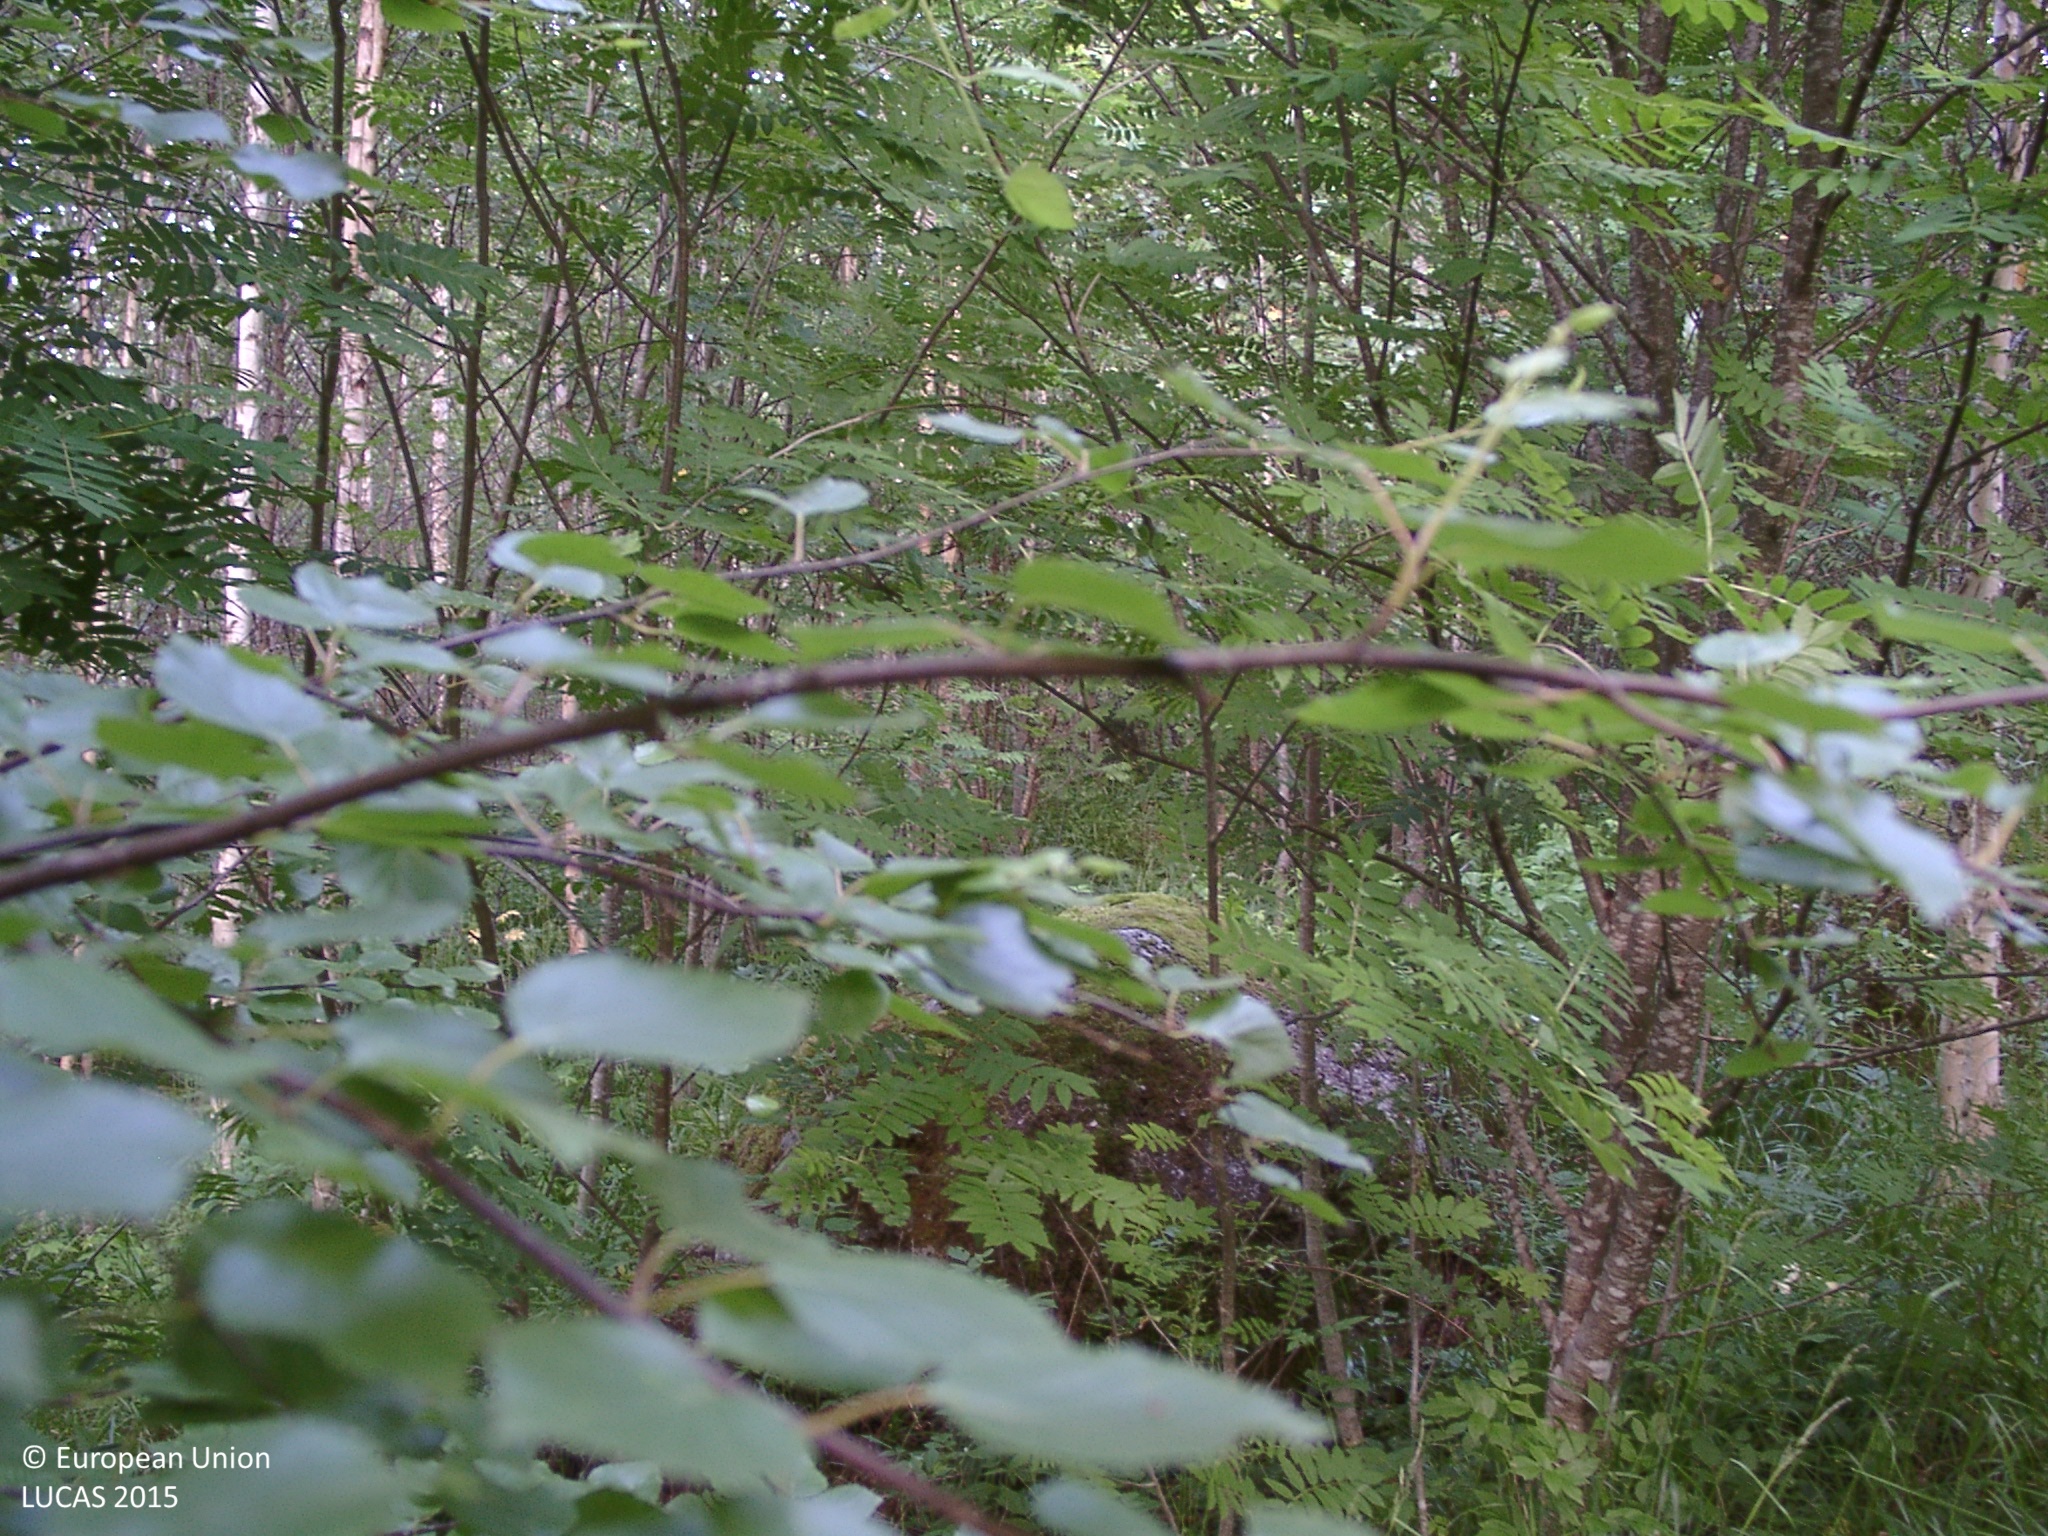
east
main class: Woodland
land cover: Broadleaved woodland
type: non-riverine alder, birch or aspen forest
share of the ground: > 75 %
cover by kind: broadleaved forest trees 75 %, herbaceous plants 20 %, shrubs 5 %
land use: Semi-natural and natural areas not in use
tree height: > 5 m
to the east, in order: Broadleaved woodland; Grass margins; Tracks; Grassland with sparse tree/shrub cover; Spruce dominated mixed woodland; Electric lines; Tracks; Broadleaved woodland; Ditches and canals; Grass margins; Tracks; Spruce dominated mixed woodland
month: July
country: FI
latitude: 61.6112
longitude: 25.2155
